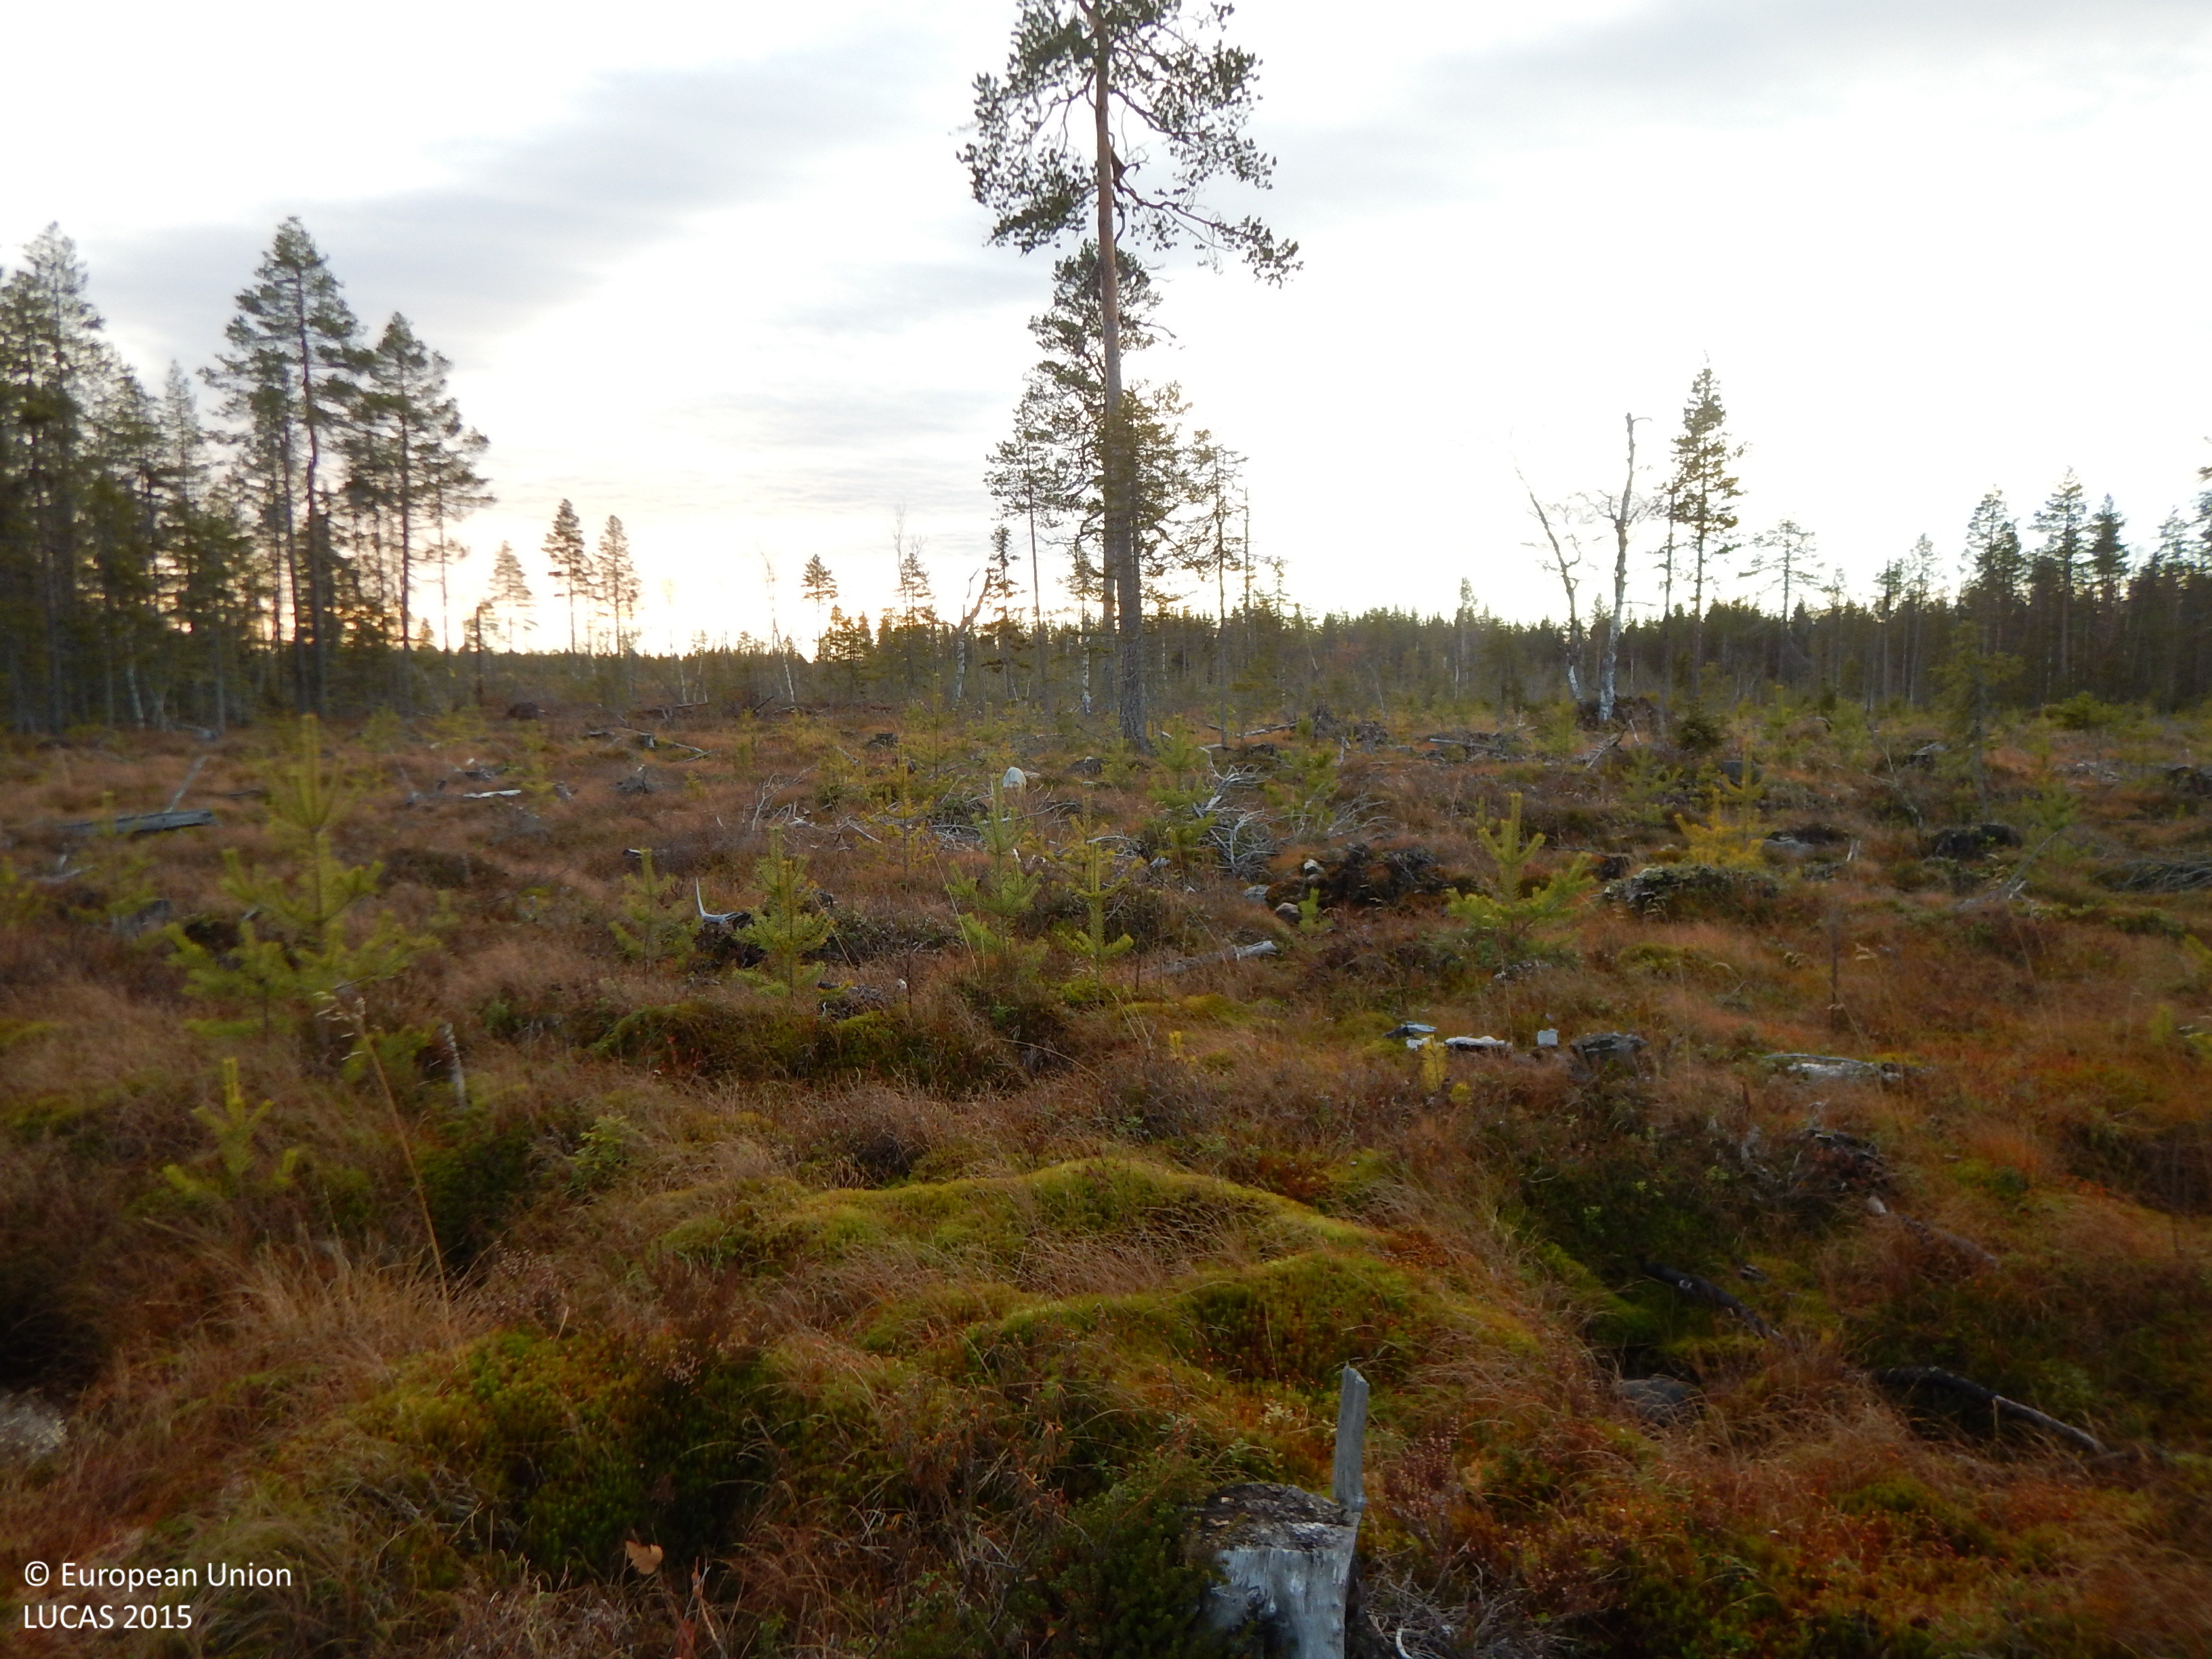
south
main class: Woodland
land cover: Pine dominated coniferous woodland
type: boreal forest
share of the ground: 25 - 50 %
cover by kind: lichens and mosses 30 %, shrubs 25 %, coniferous forest trees 20 %, herbaceous plants 20 %, broadleaved forest trees 5 %
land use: Forestry
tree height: < 5 m
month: November
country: SE
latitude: 65.3060
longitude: 20.5453
